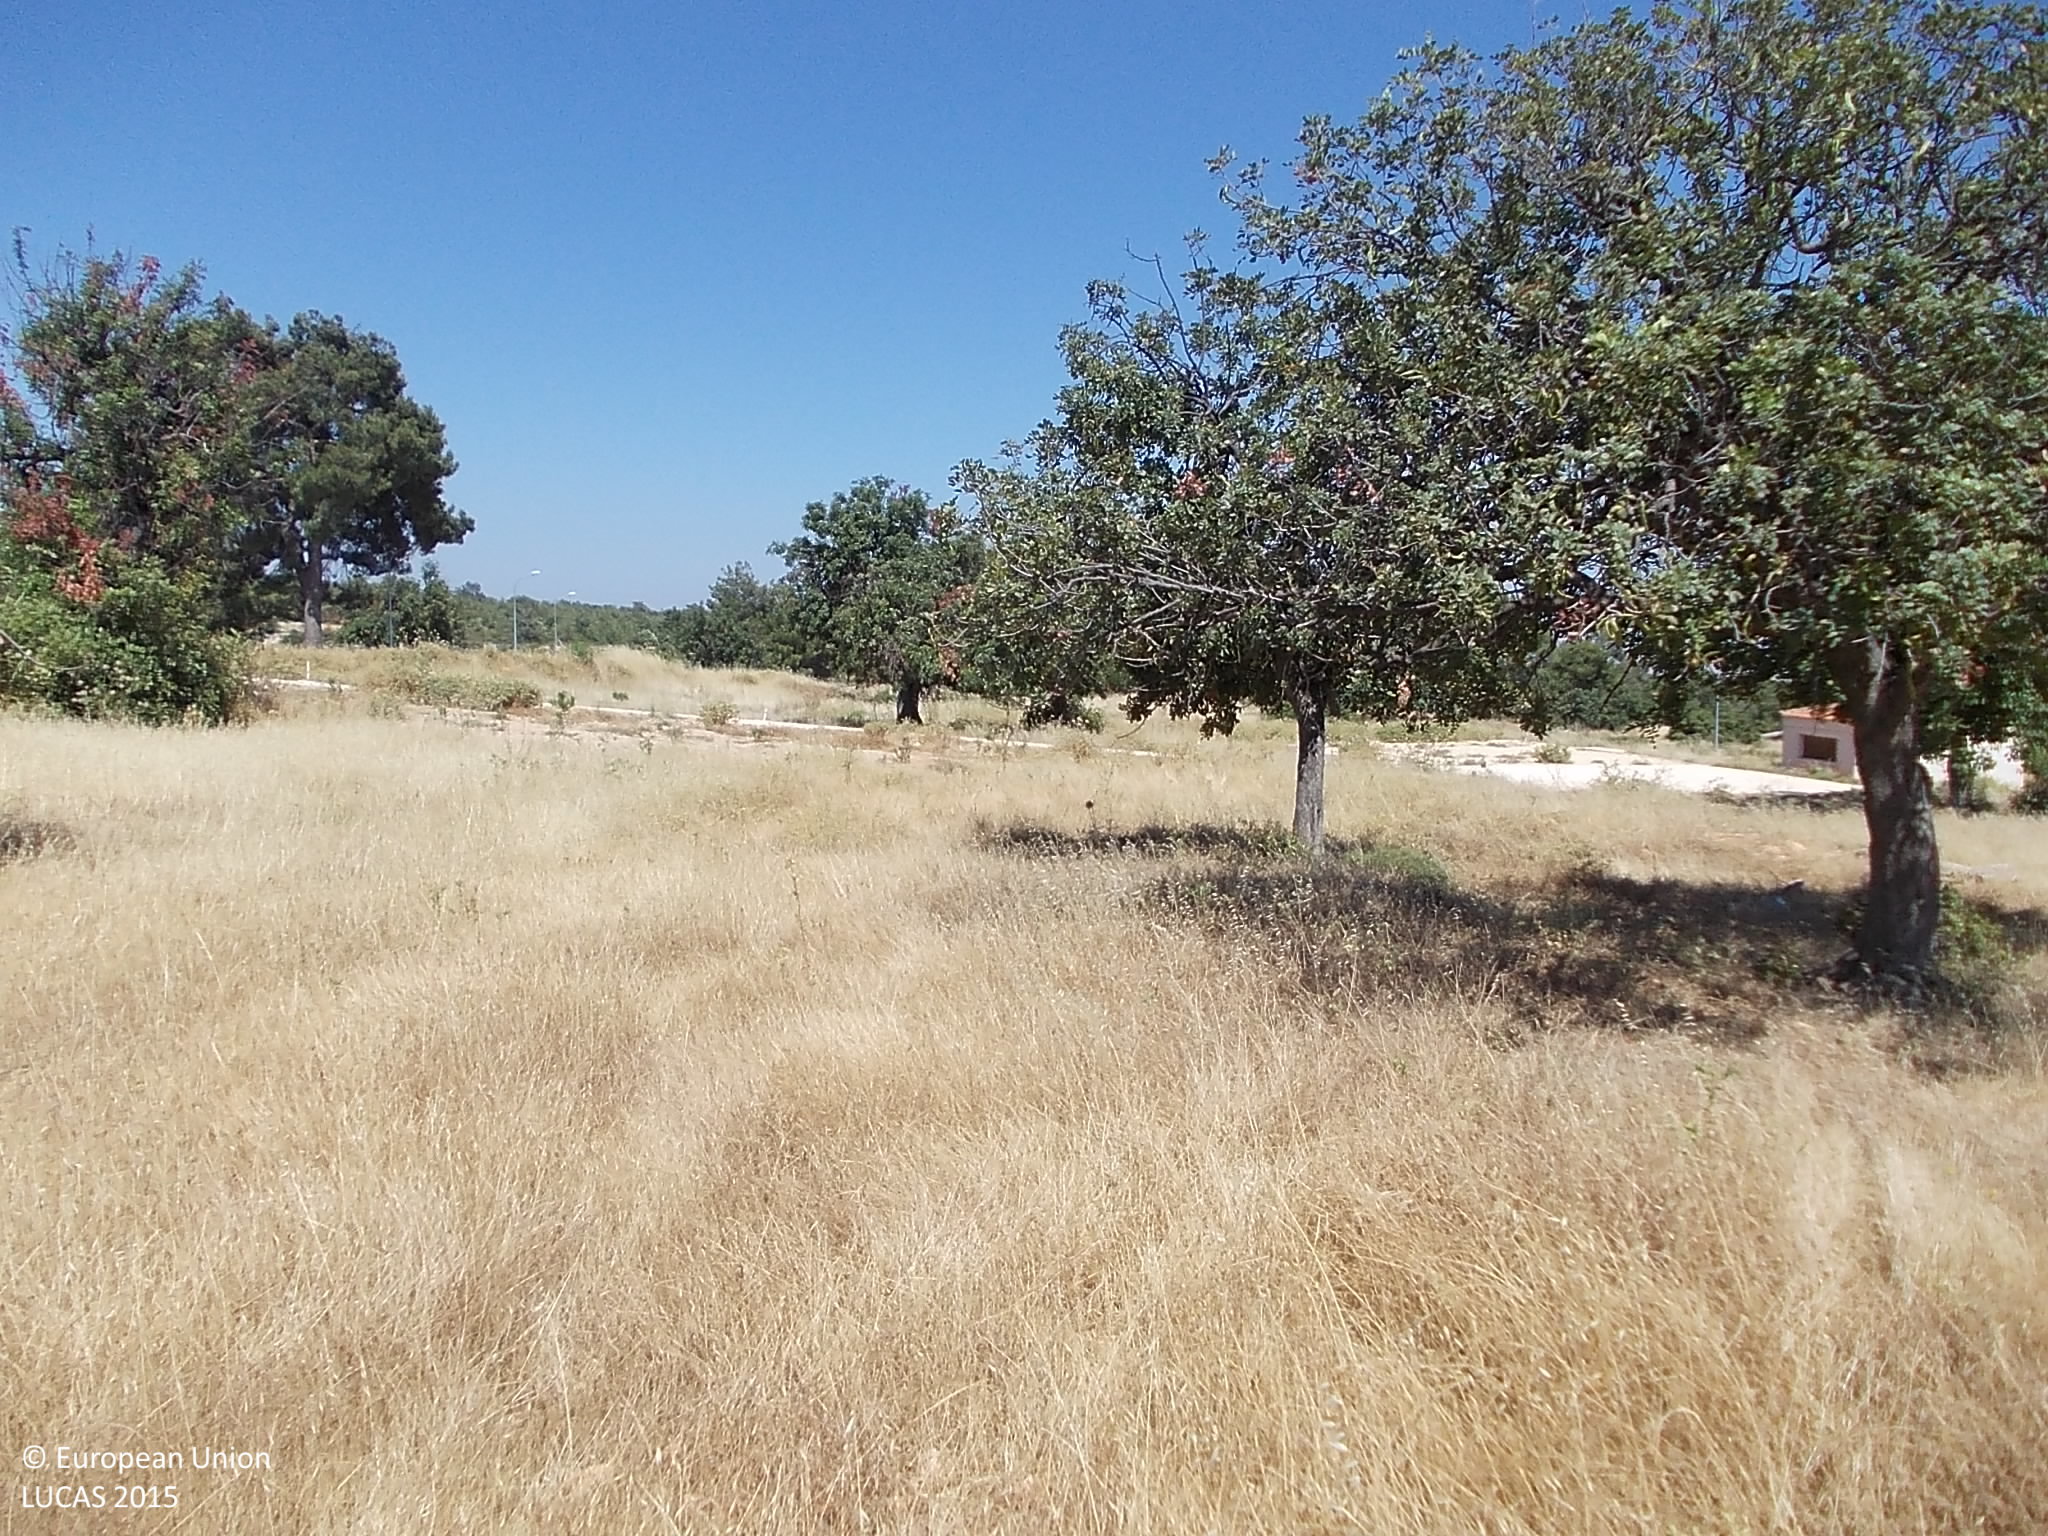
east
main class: Grassland
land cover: Grassland with sparse tree/shrub cover
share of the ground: > 75 %
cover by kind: herbaceous plants 85 %, unconsolidated bare surface 10 %, broadleaved forest trees 5 %
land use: Semi-natural and natural areas not in use
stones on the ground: 10 - 25 %
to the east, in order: Grassland with sparse tree/shrub cover; Shrubland with sparse tree cover; Tracks; Shrubland with sparse tree cover; Grassland with sparse tree/shrub cover; Tracks; Broadleaved woodland; Electric lines; Shrubland with sparse tree cover; Rocks and stones; Tracks; Rocks and stones; Paved roads, cycling and walking lanes; Shrubland without tree cover
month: June
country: CY
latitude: 34.7465
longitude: 32.8923
